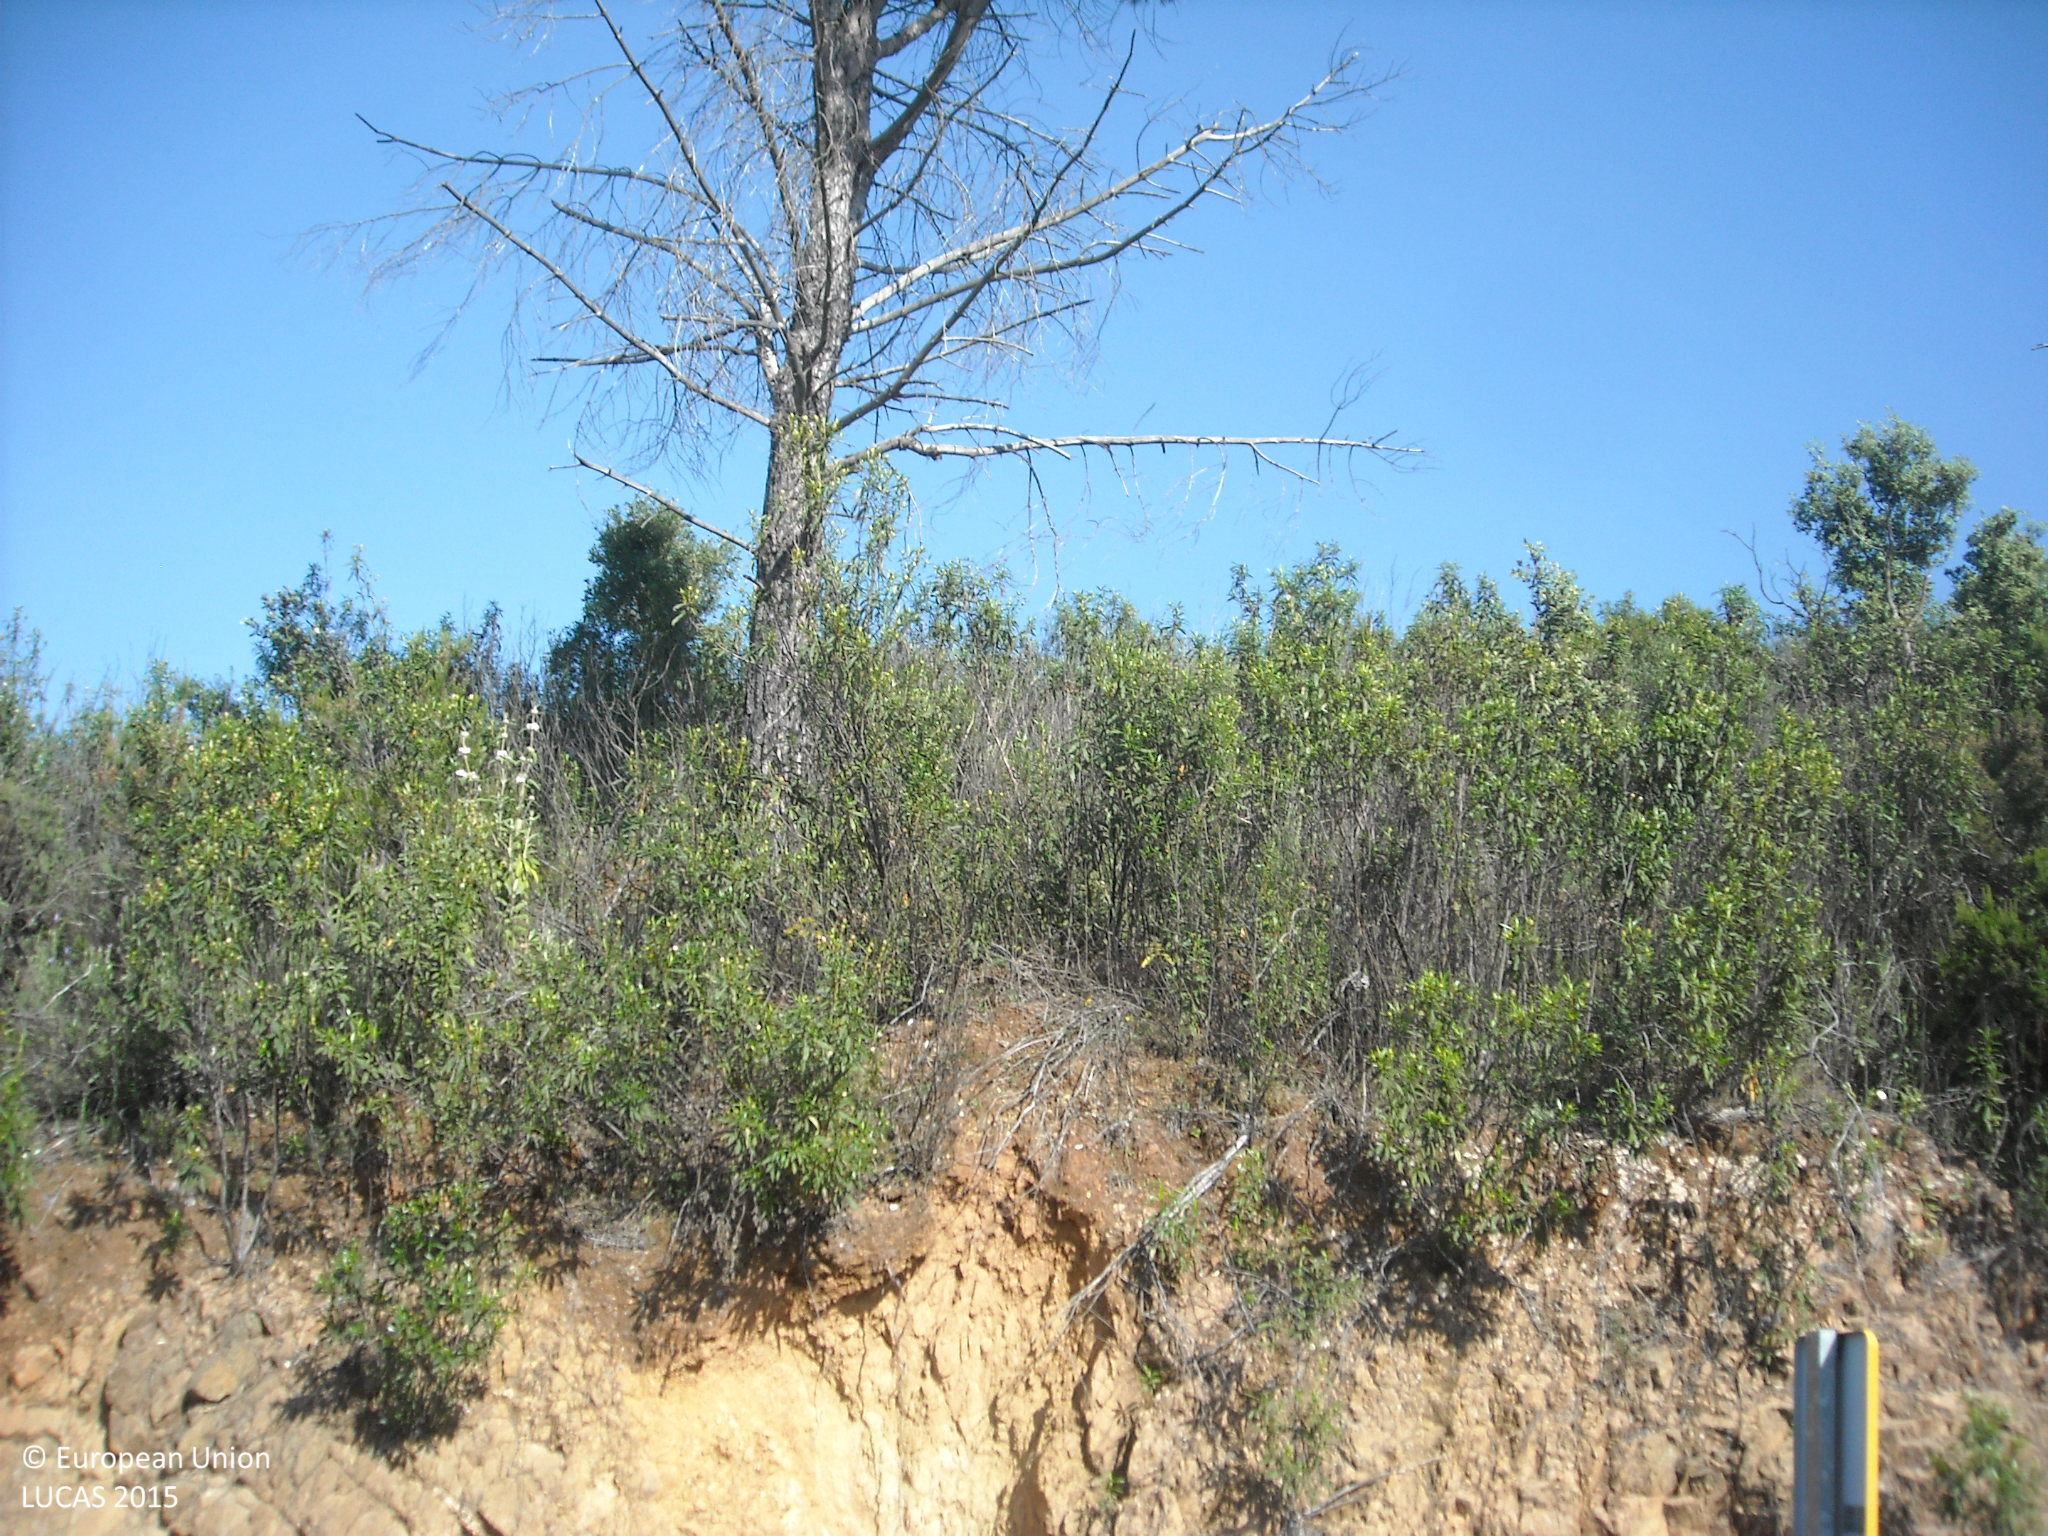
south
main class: Shrubland
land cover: Shrubland without tree cover
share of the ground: > 75 %
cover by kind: shrubs 75 %, herbaceous plants 25 %
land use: Semi-natural and natural areas not in use
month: April
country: ES
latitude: 37.6458
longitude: -6.4822
